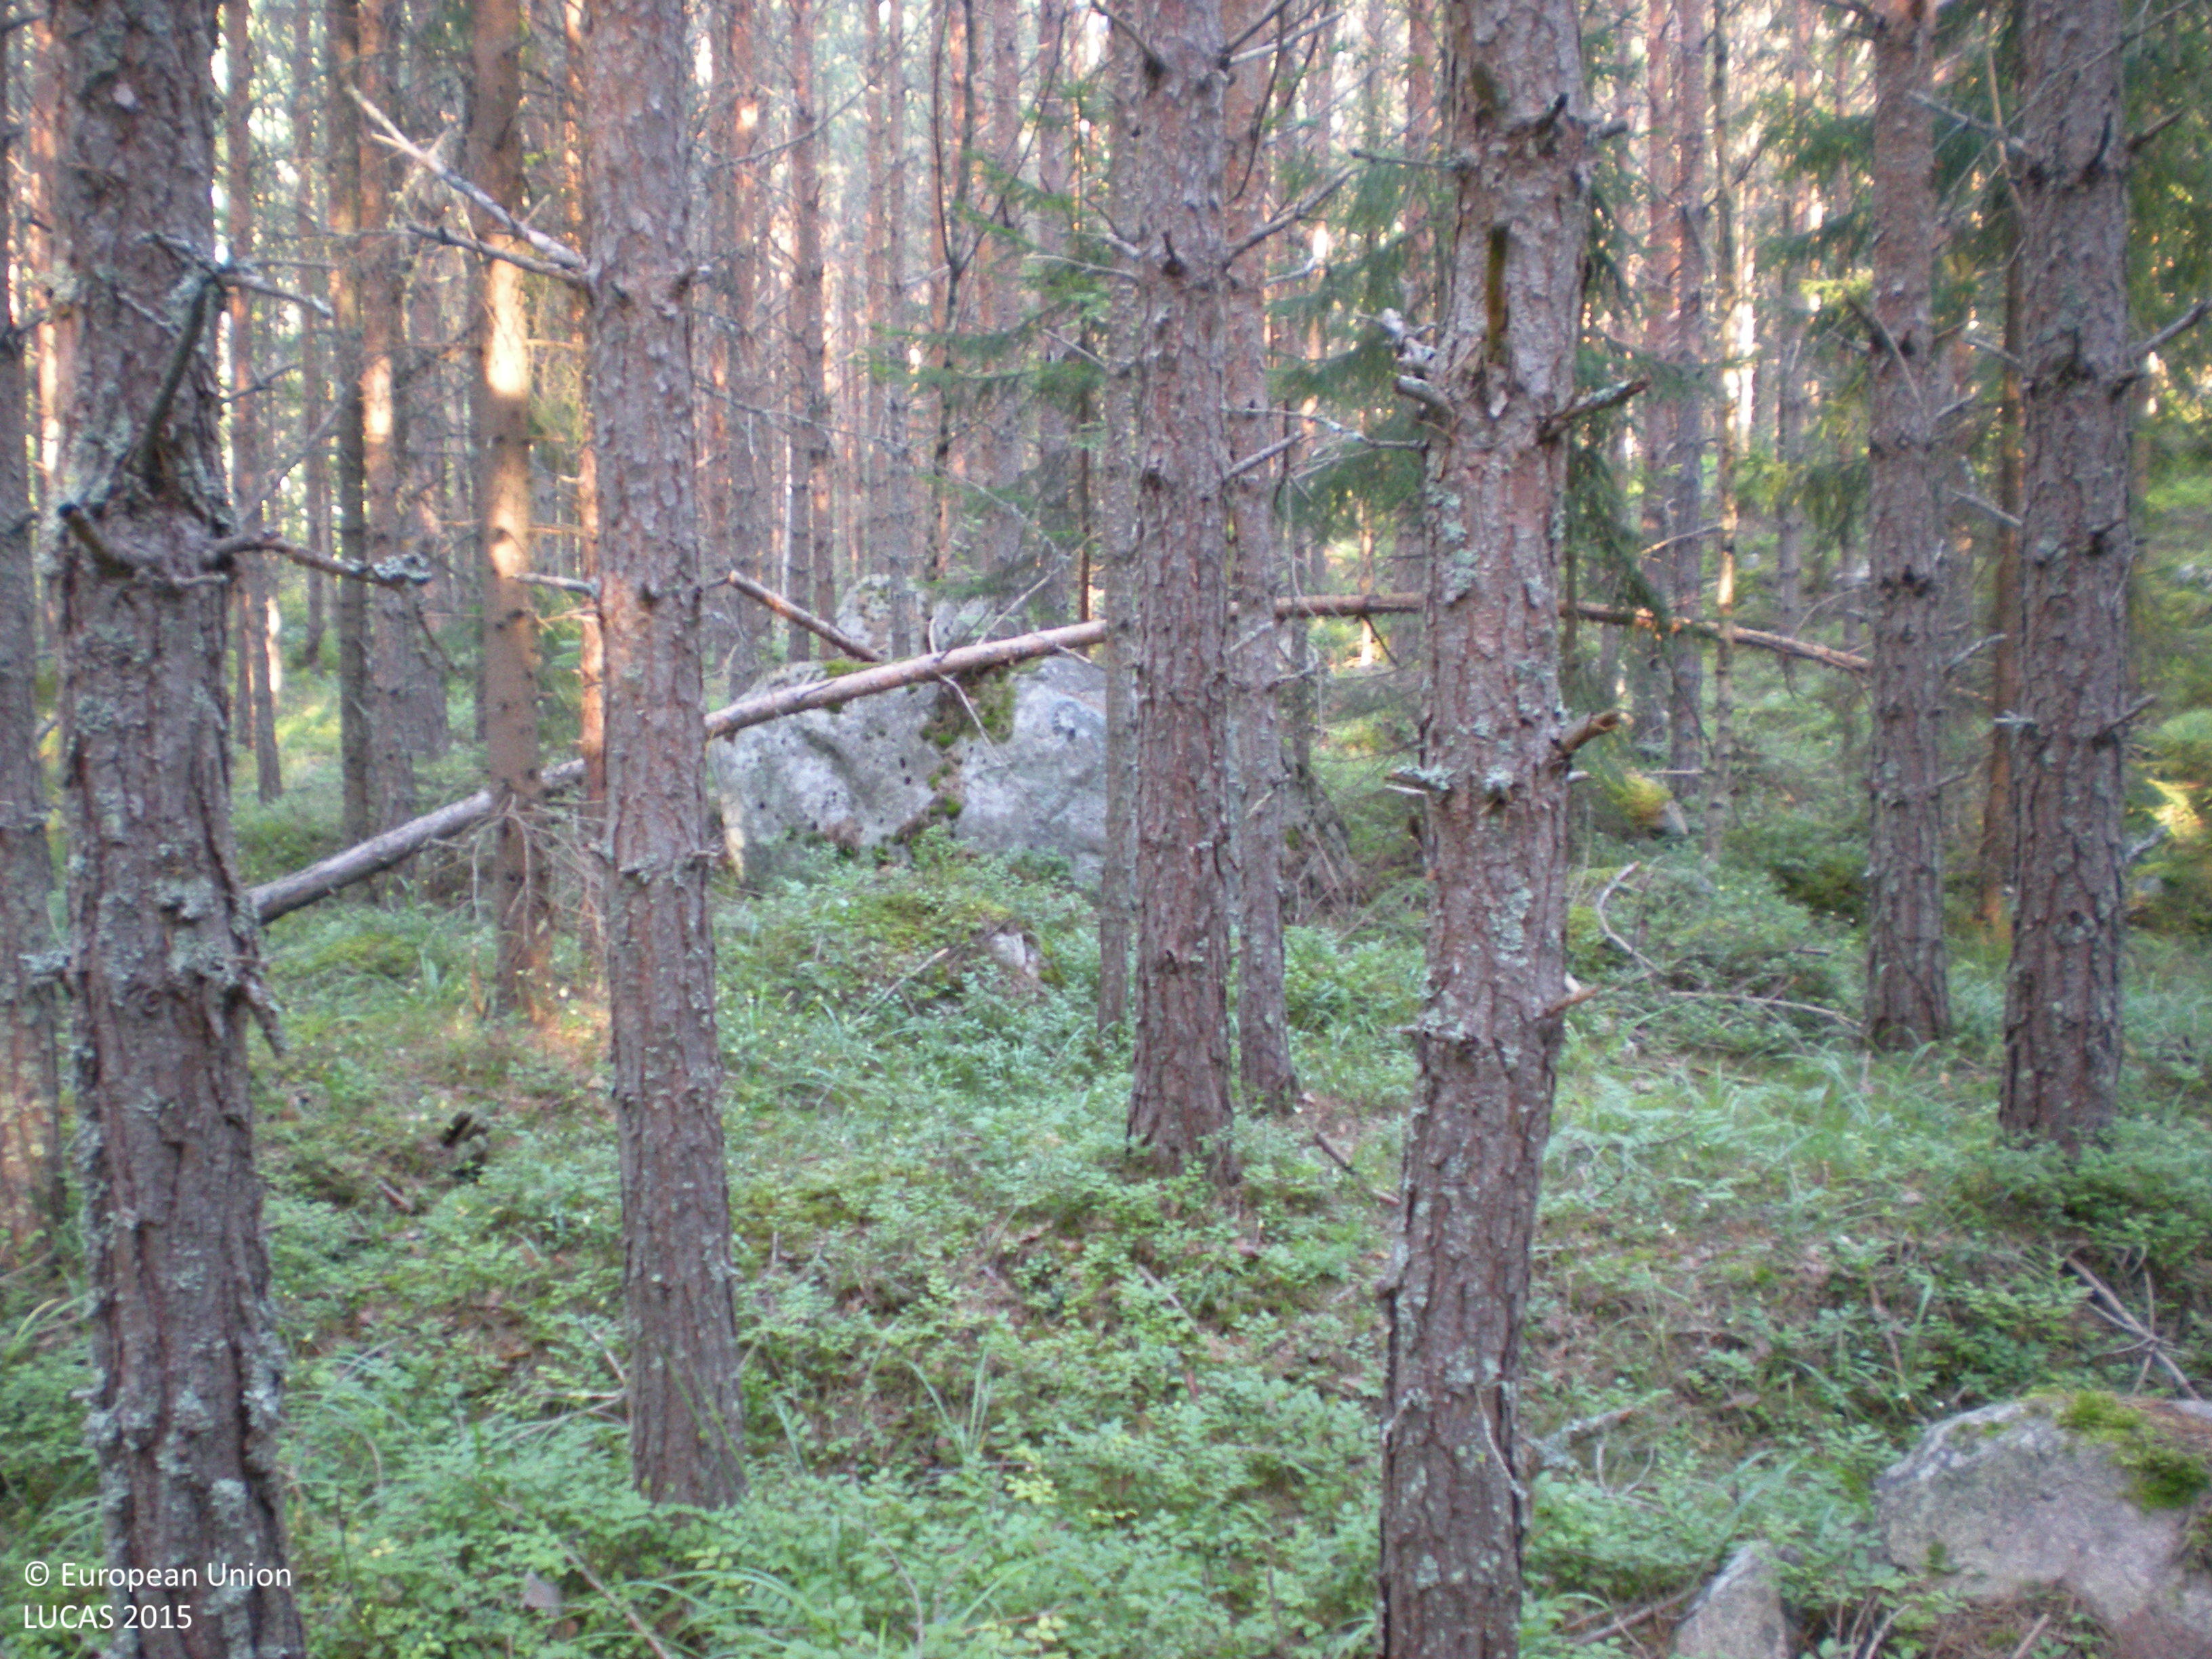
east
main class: Woodland
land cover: Pine dominated coniferous woodland
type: boreal forest
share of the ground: > 75 %
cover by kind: coniferous forest trees 85 %, shrubs 5 %, herbaceous plants 5 %, lichens and mosses 5 %
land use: Forestry
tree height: > 5 m
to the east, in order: Pine dominated coniferous woodland; Other mixed woodland
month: August
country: SE
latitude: 60.6830
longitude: 16.8542
